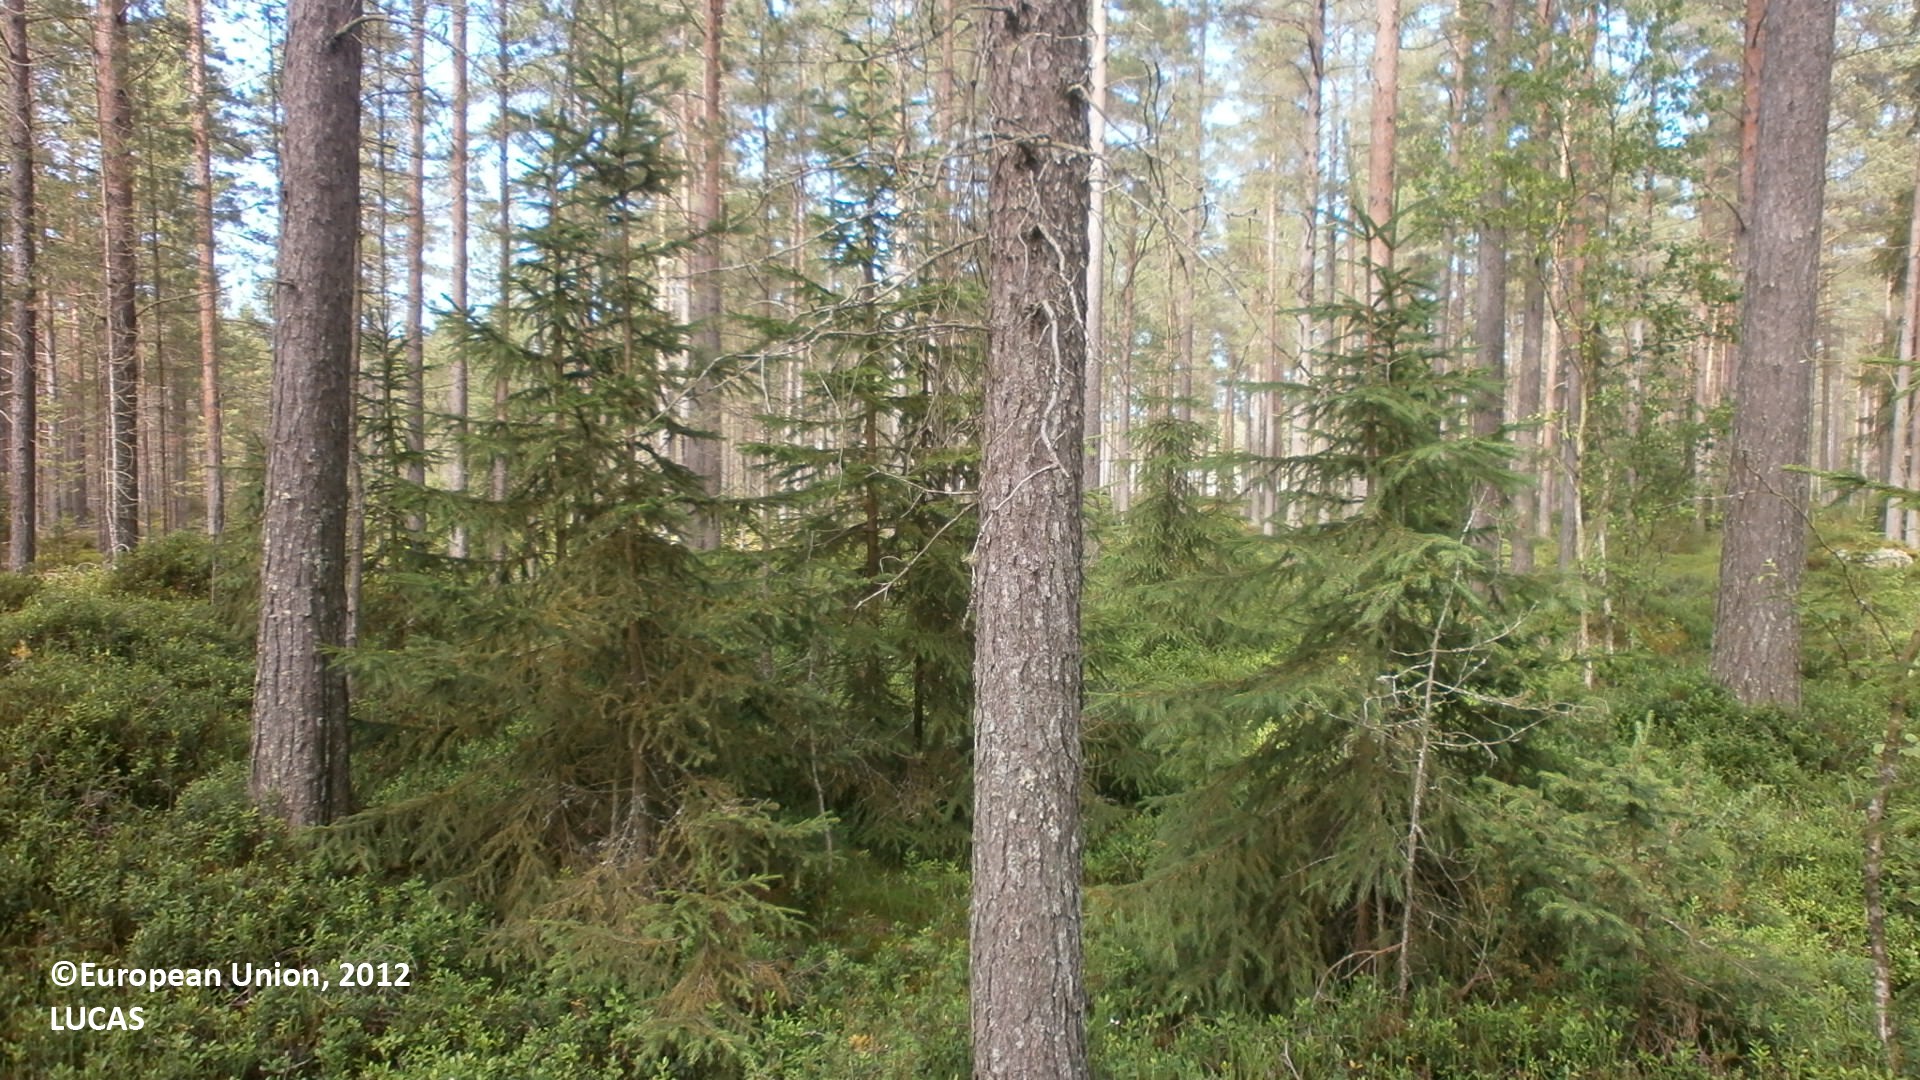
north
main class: Woodland
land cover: Pine dominated coniferous woodland
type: boreal forest
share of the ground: 50 - 75 %
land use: Forestry
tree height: > 5 m
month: July
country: FI
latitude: 64.2461
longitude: 23.8601
